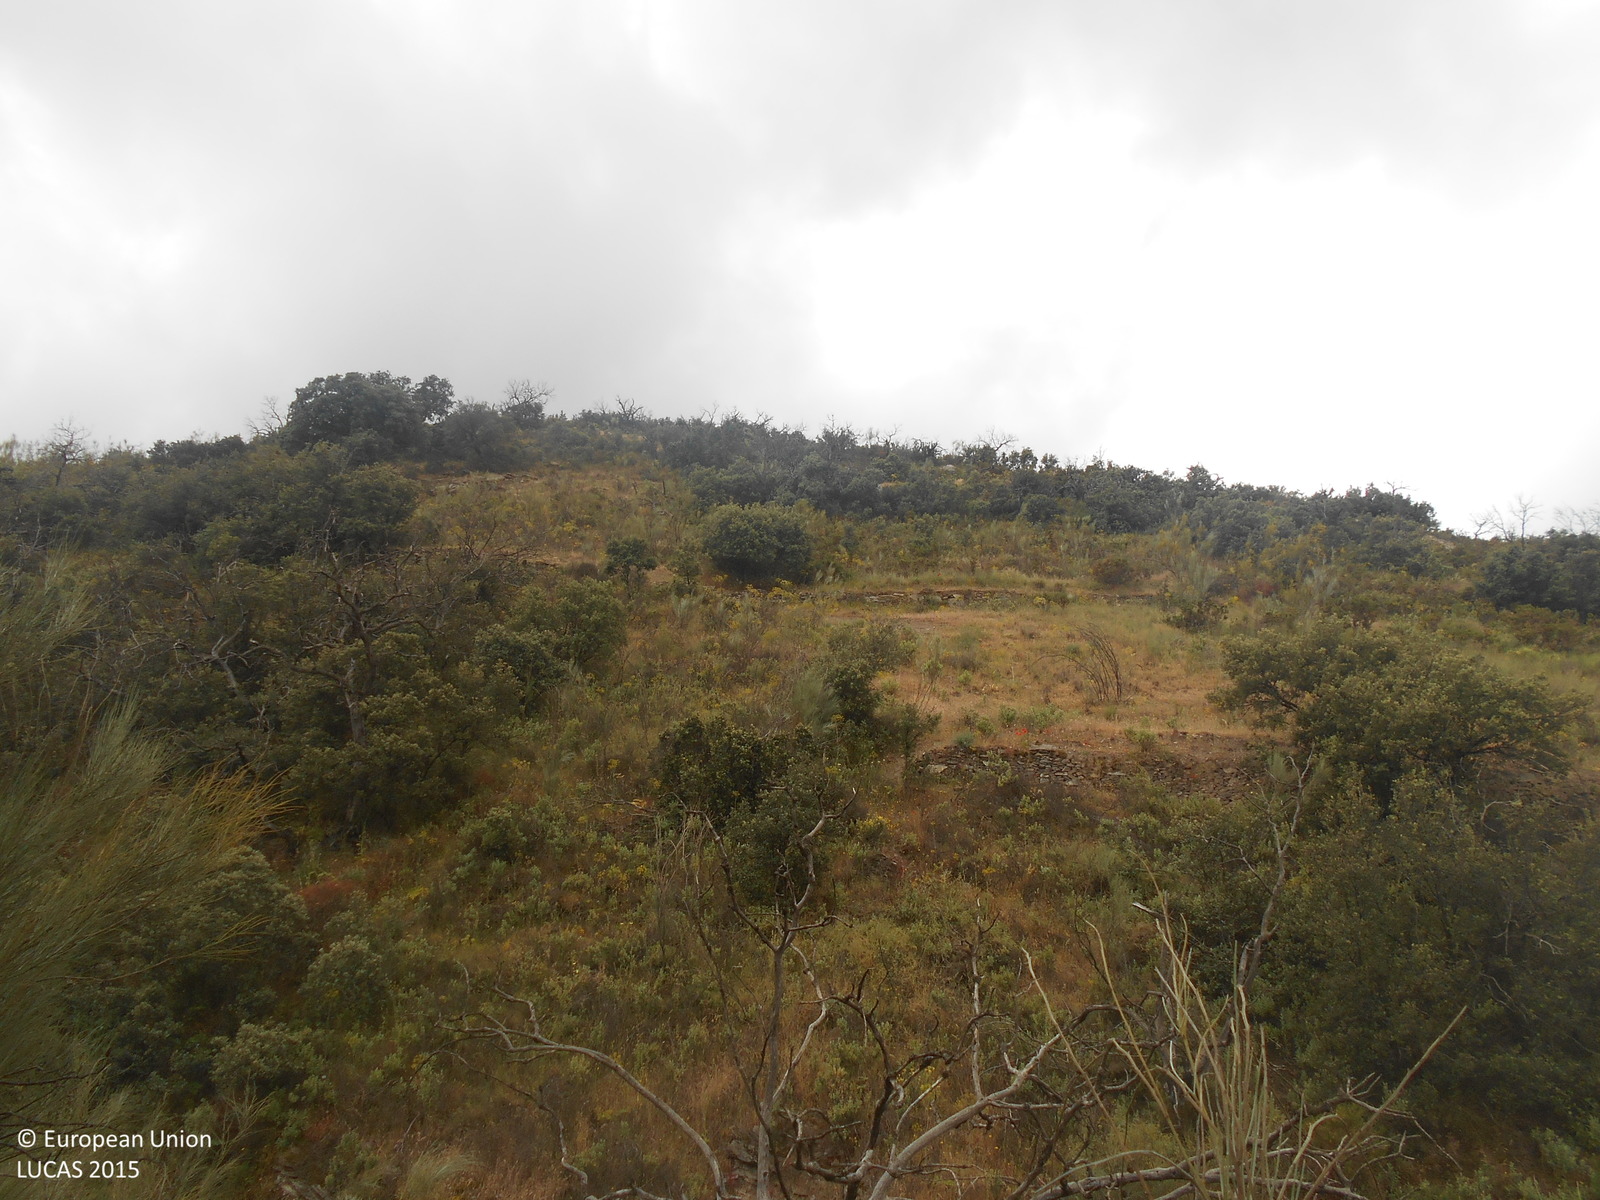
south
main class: Shrubland
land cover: Shrubland without tree cover
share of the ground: 25 - 50 %
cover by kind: shrubs 40 %, herbaceous plants 40 %, consolidated bare surface 10 %, unconsolidated bare surface 10 %
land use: Semi-natural and natural areas not in use
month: May
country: ES
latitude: 37.2325
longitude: -2.2089
